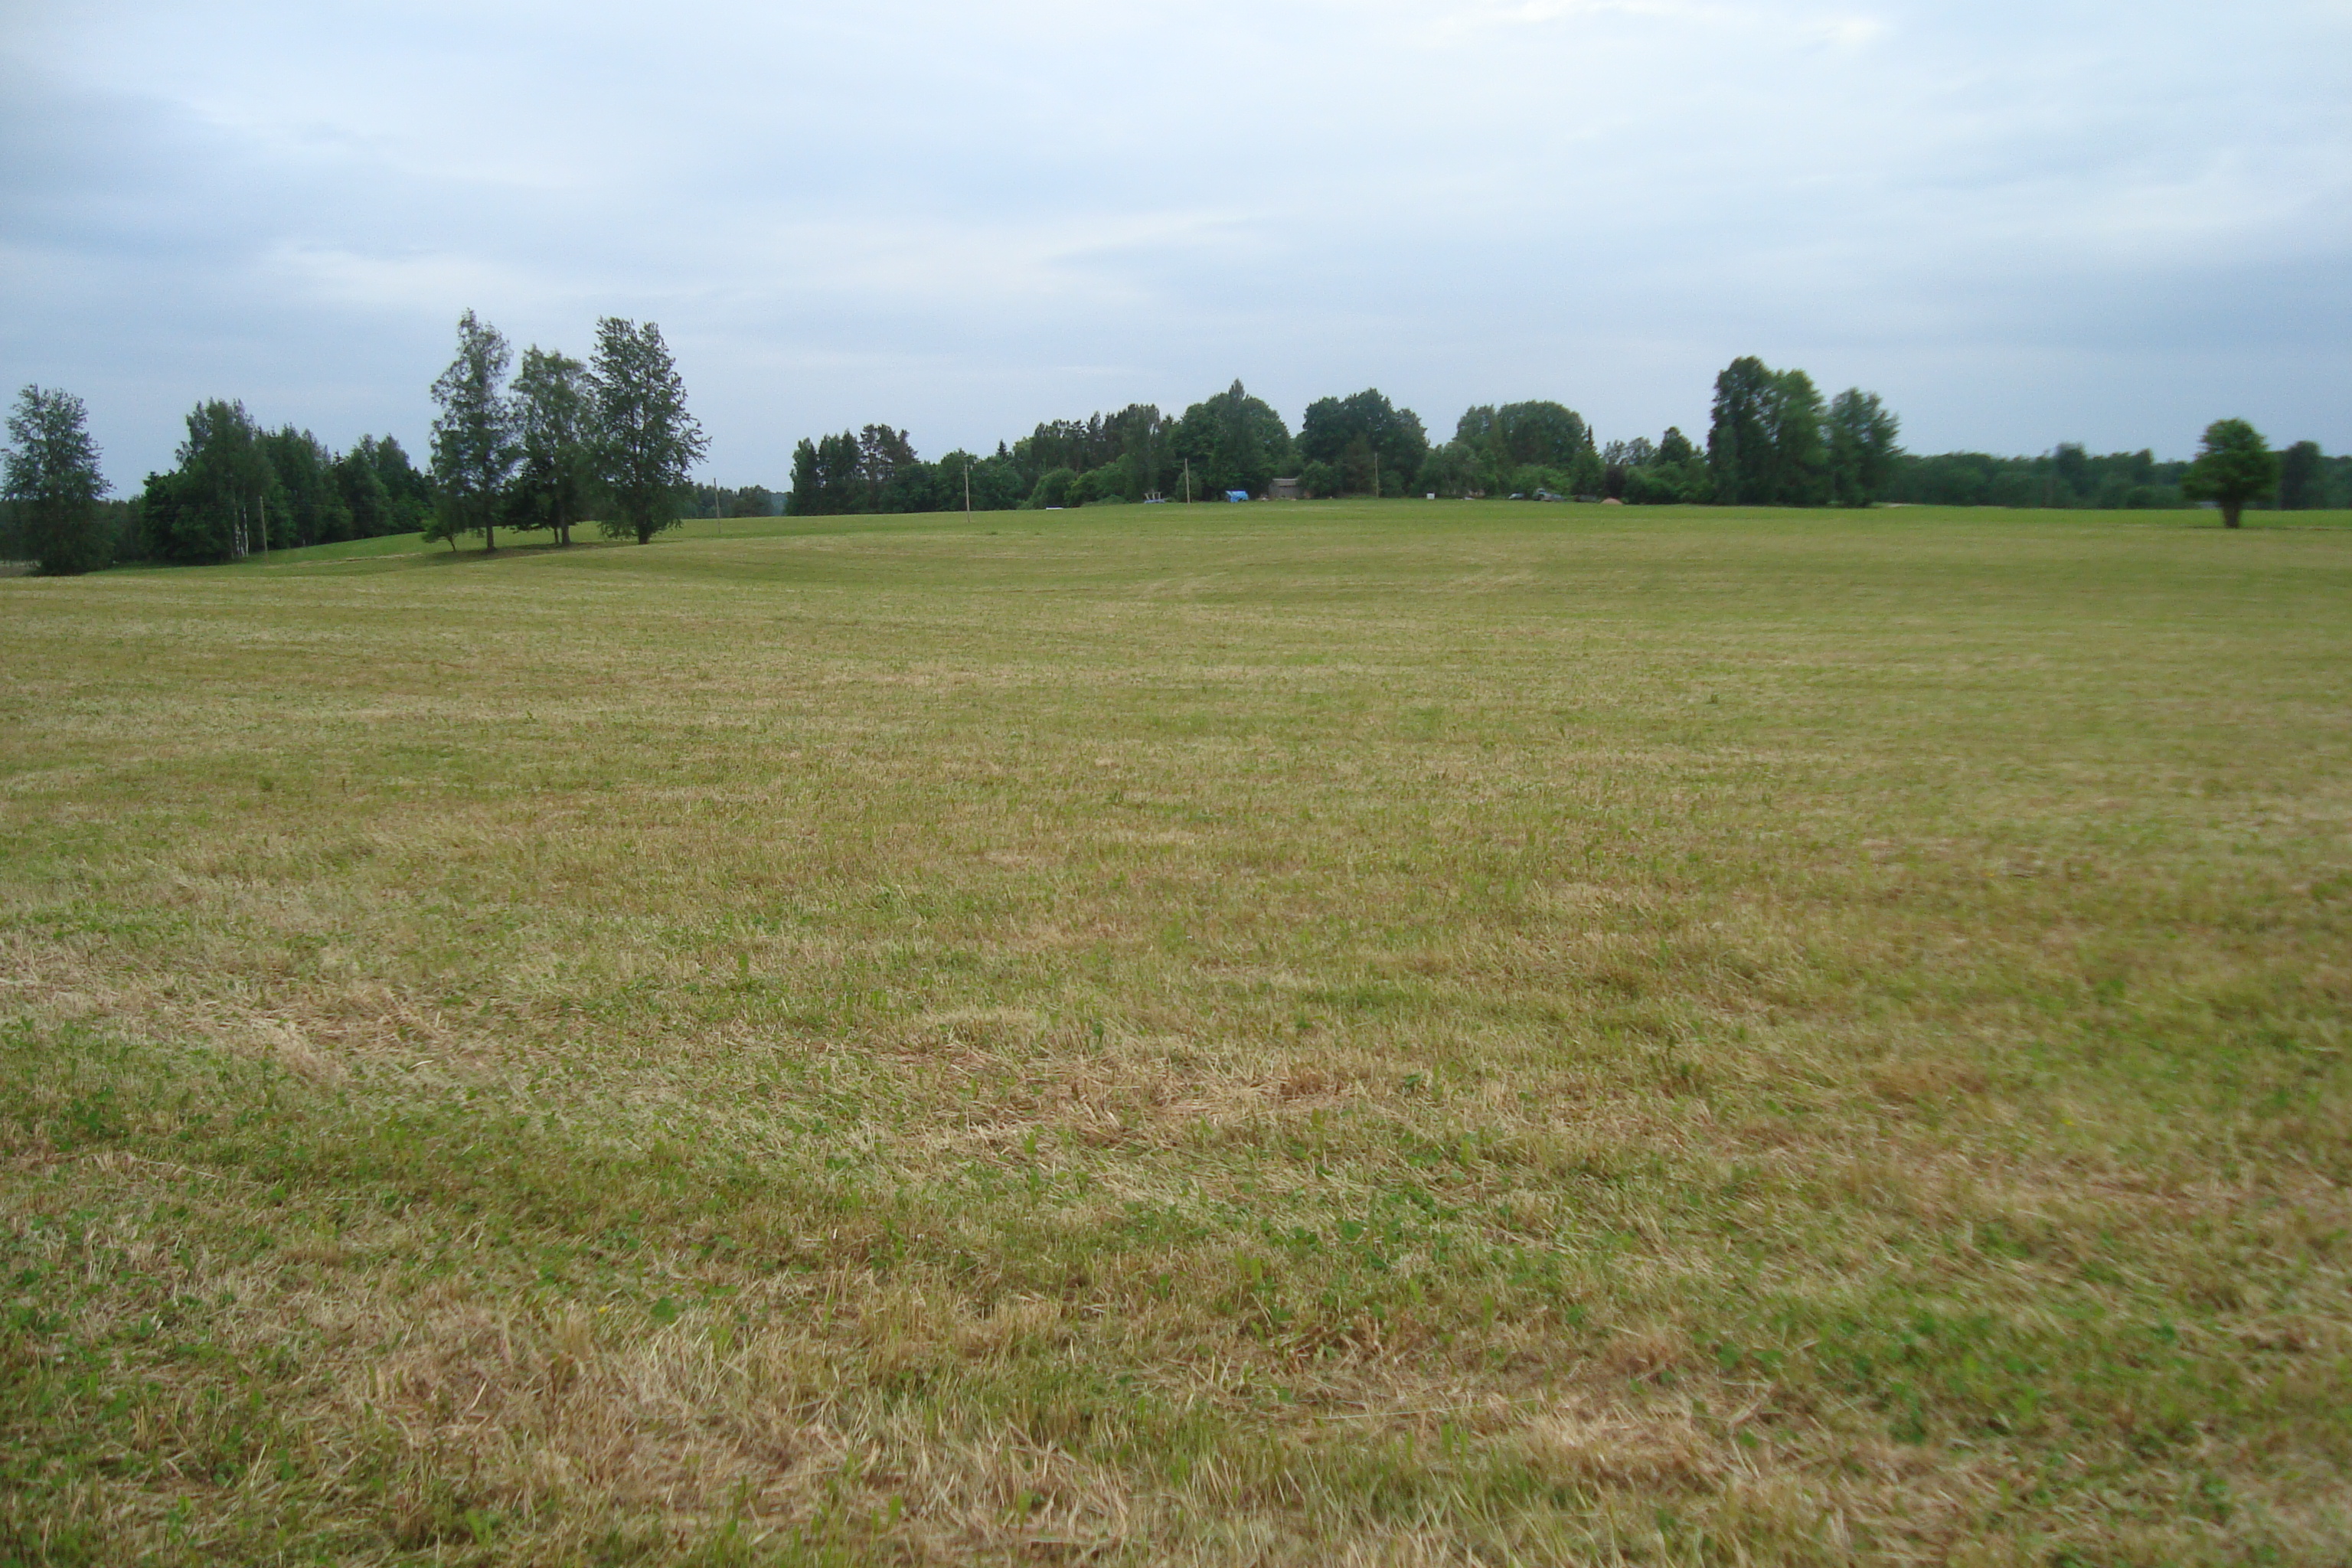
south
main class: Grassland
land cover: Grassland without tree/shrub cover
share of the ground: > 75 %
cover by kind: herbaceous plants 100 %
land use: Agriculture (excluding fallow land and kitchen gardens)
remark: Harvested field
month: June
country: LV
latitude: 57.2172
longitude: 26.4196
